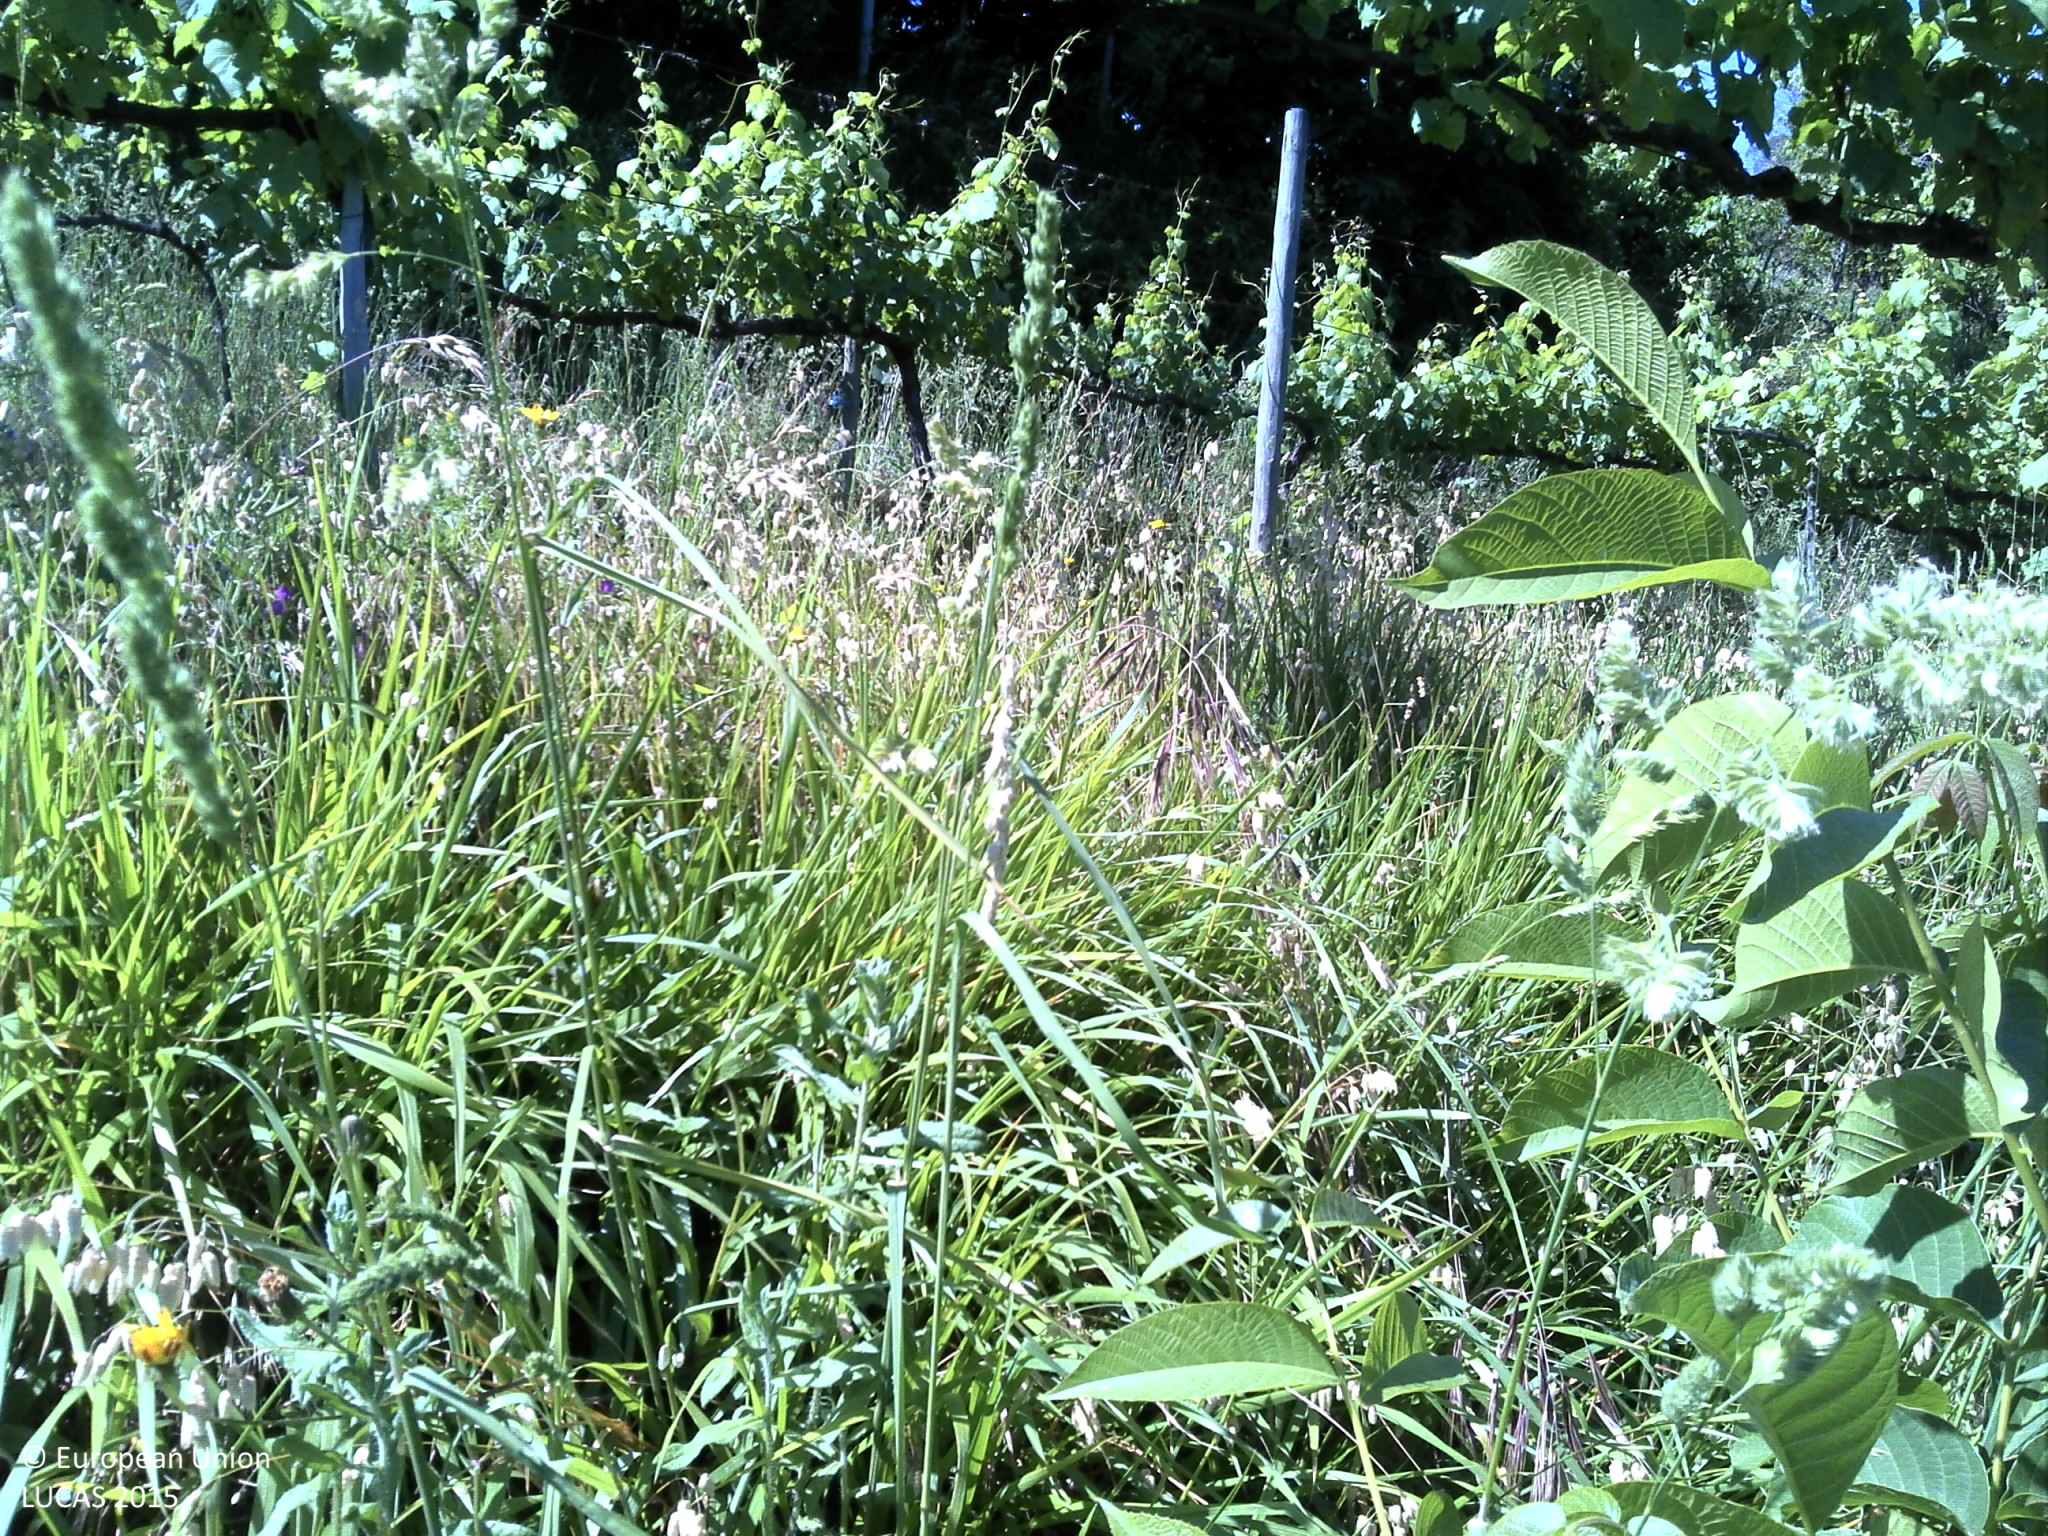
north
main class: Cropland
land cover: Vineyards
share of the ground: 10 - 25 %
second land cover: Grassland without tree/shrub cover
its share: 50 - 75 %
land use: Agriculture (excluding fallow land and kitchen gardens)
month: June
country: PT
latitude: 41.8419
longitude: -8.3783
